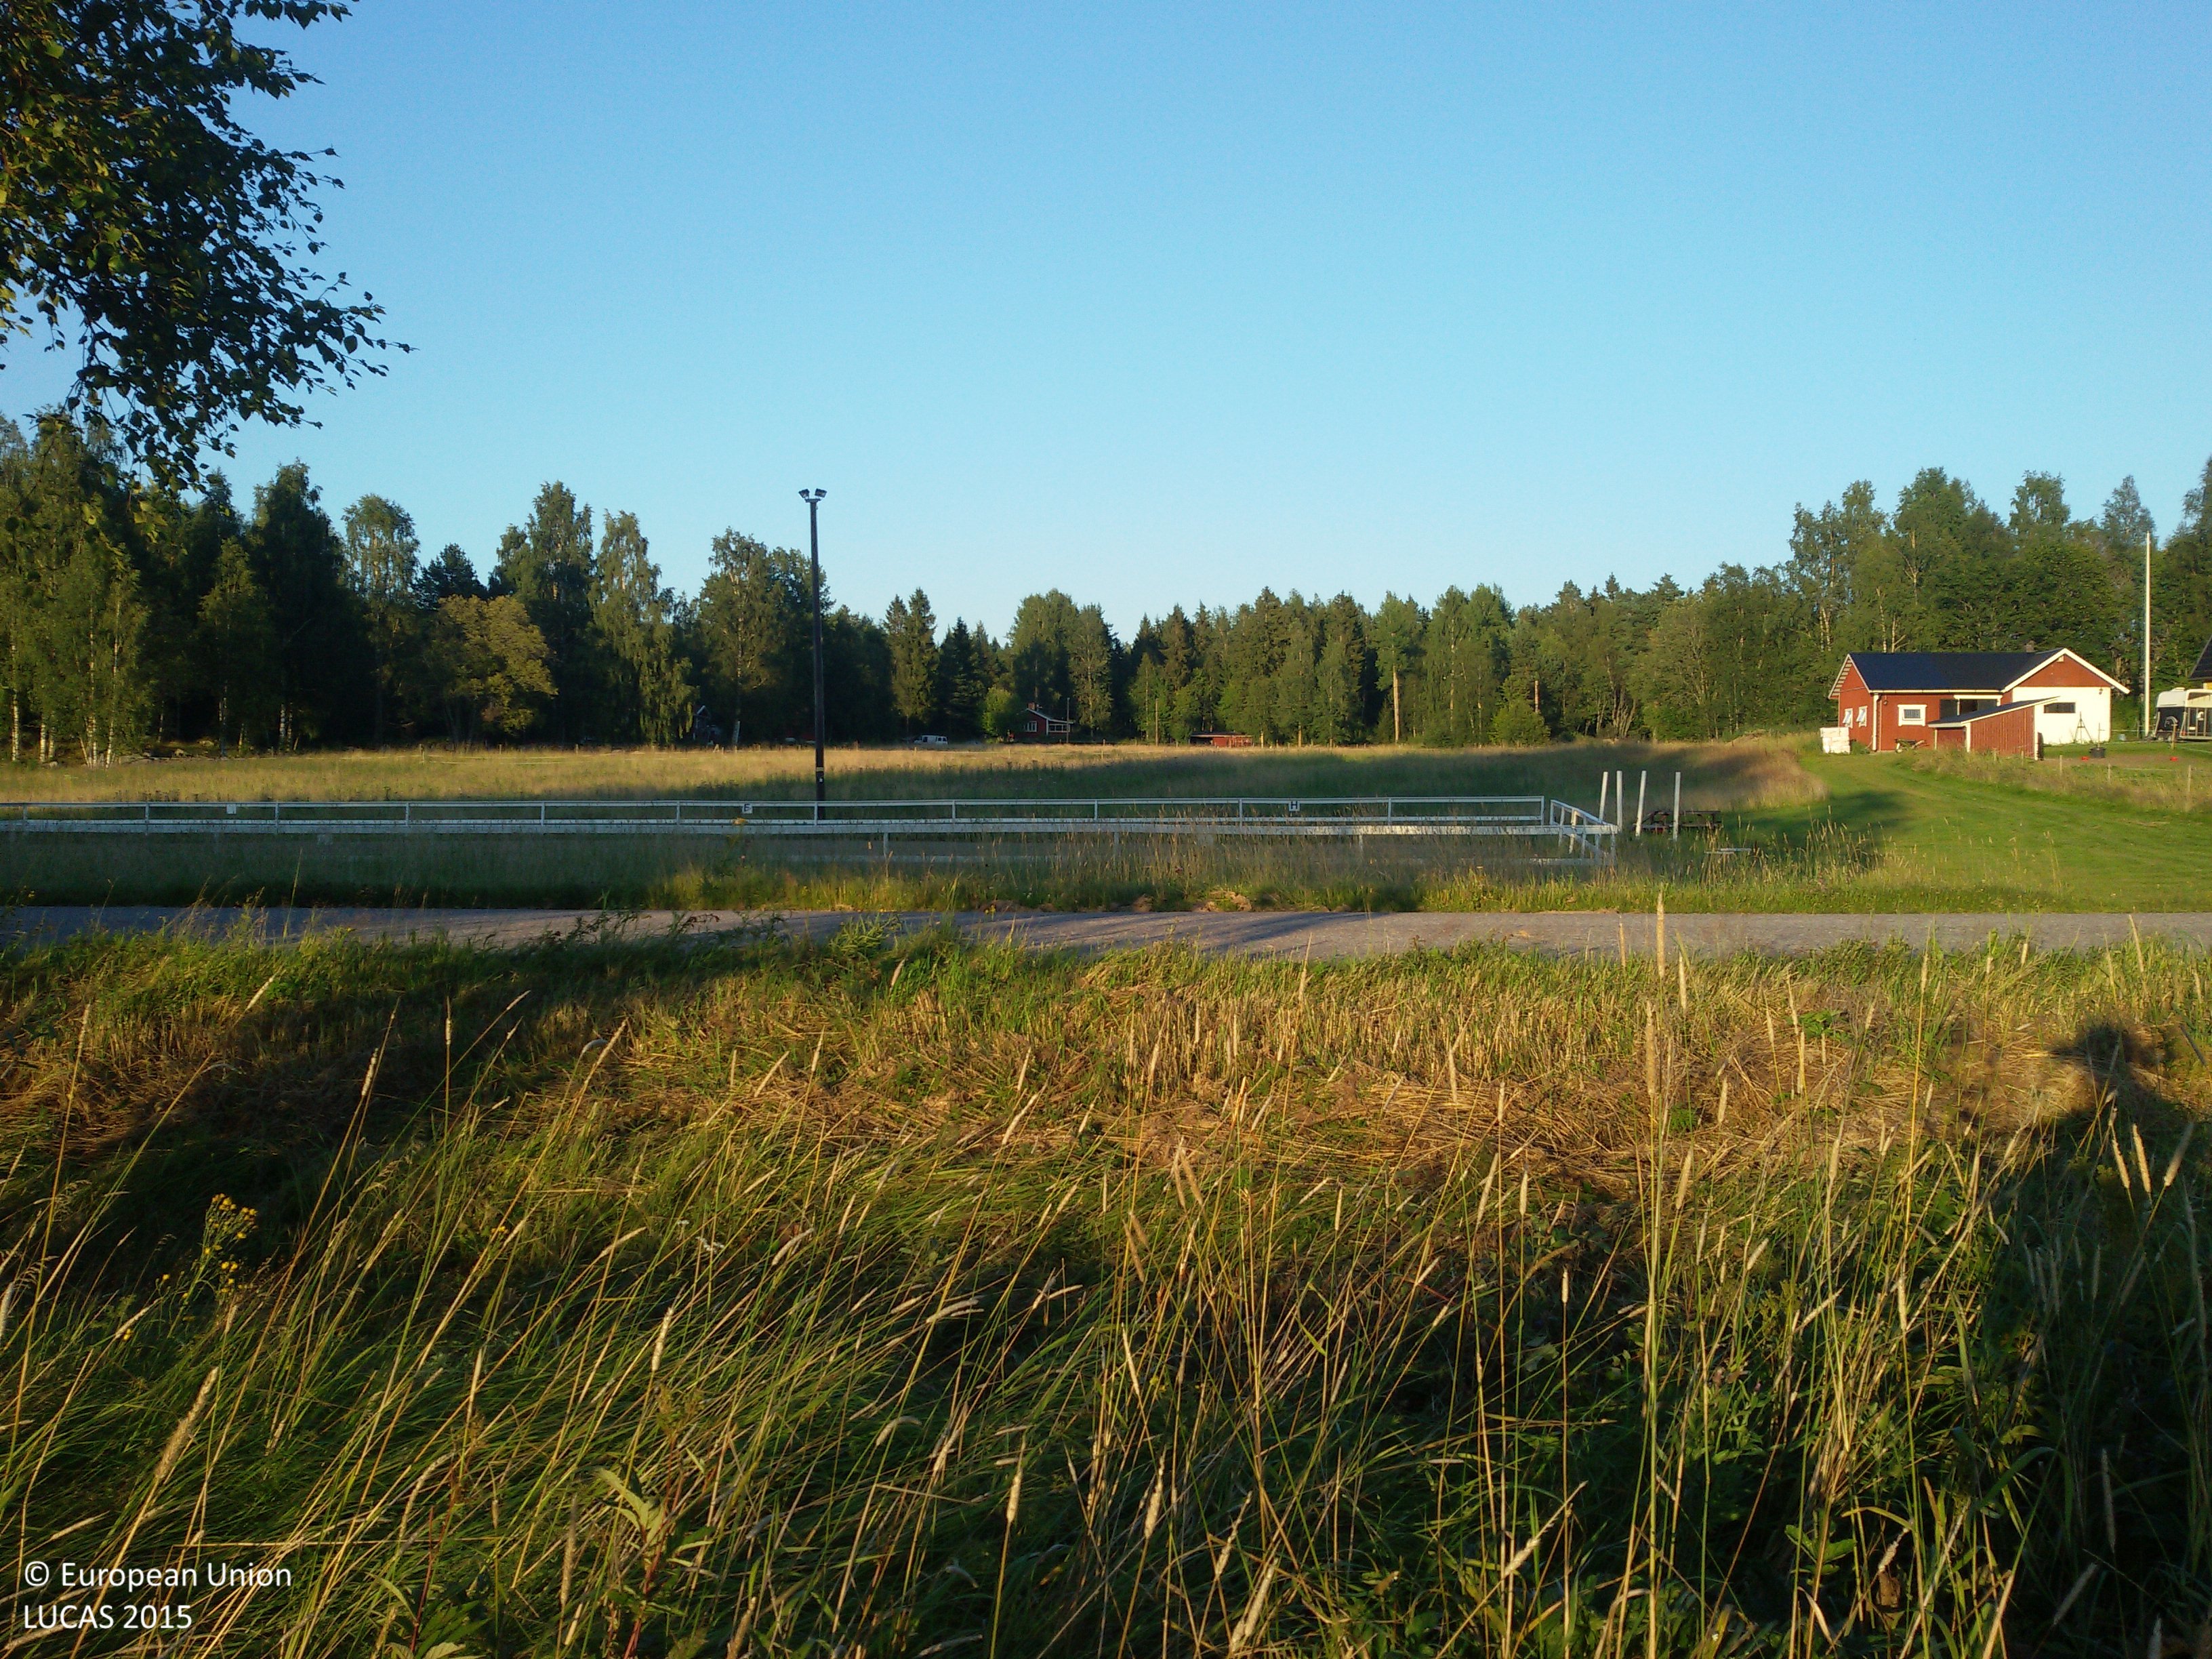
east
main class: Cropland
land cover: Barley
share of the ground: > 75 %
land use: Agriculture (excluding fallow land and kitchen gardens)
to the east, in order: Barley; Broadleaved woodland; Ditches and canals; Grass margins; Paved roads, cycling and walking lanes; Grass margins; Ditches and canals; Grassland without tree/shrub cover; Fences; Other bare soil; Fences; Grassland without tree/shrub cover
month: August
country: SE
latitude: 60.6216
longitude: 16.6217
